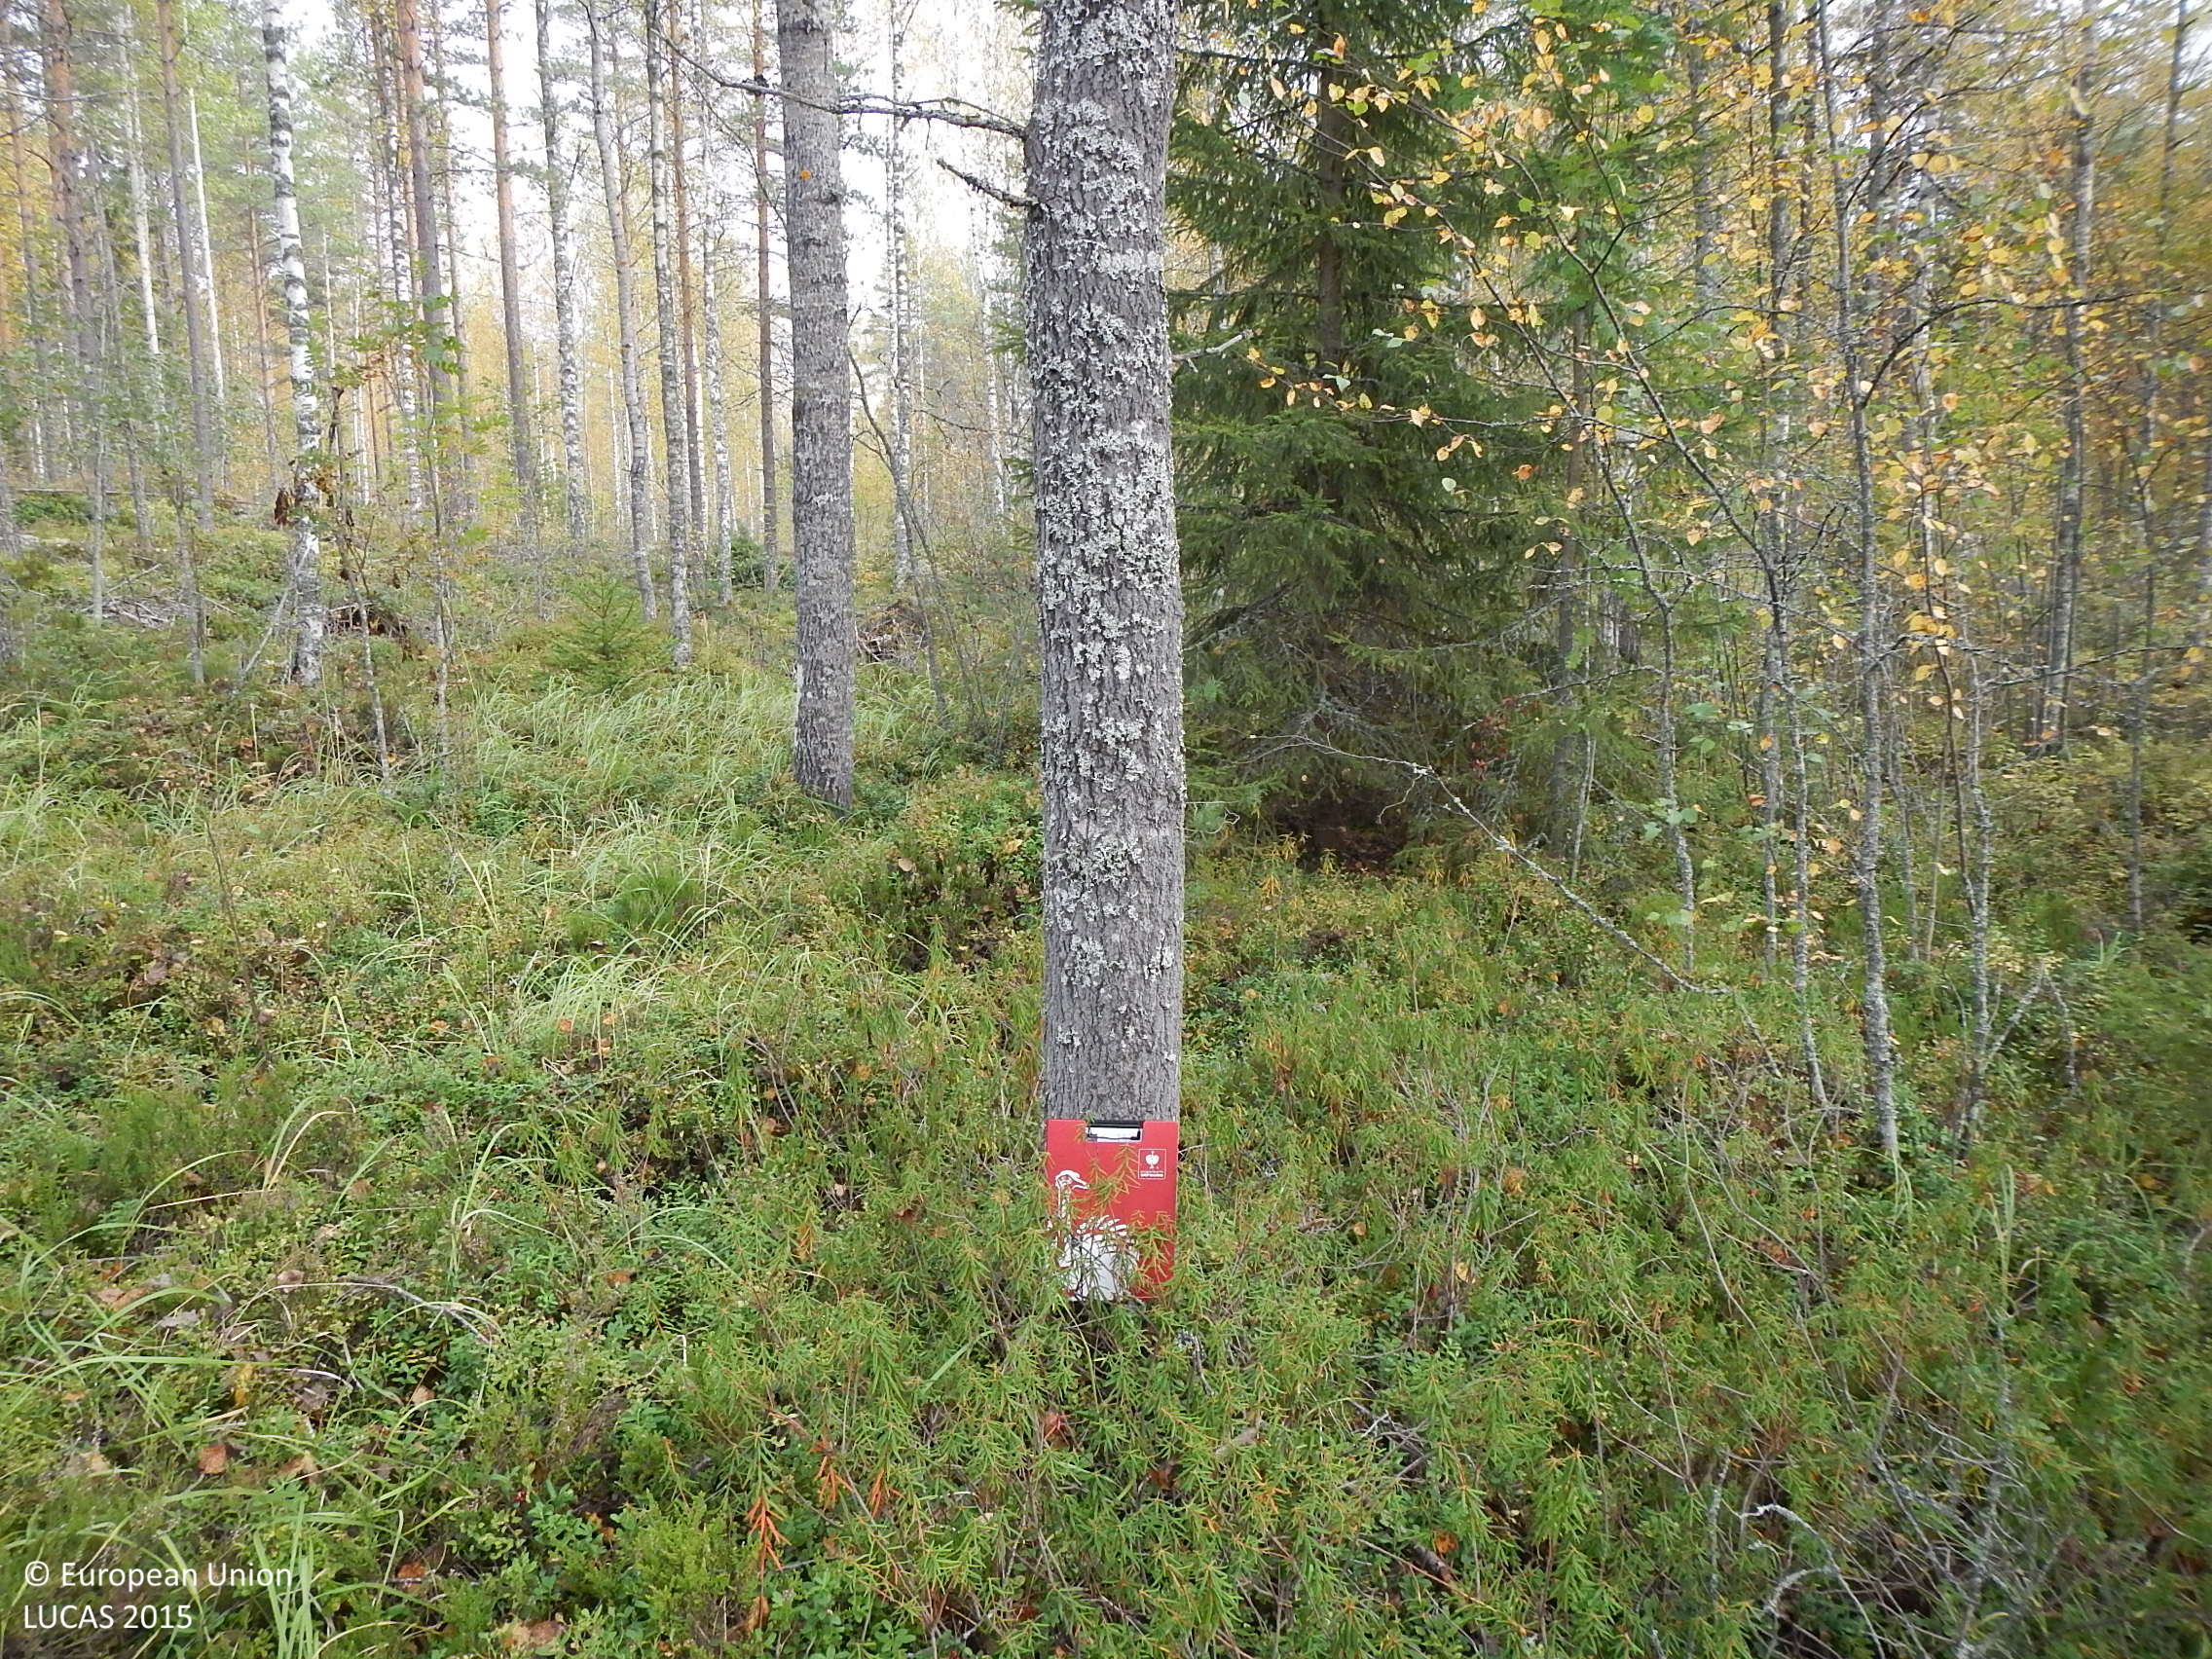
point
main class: Woodland
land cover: Pine dominated mixed woodland
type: boreal forest
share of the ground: > 75 %
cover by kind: coniferous forest trees 40 %, broadleaved forest trees 35 %, shrubs 25 %
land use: Forestry
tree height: > 5 m
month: September
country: FI
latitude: 61.9231
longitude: 22.7290
